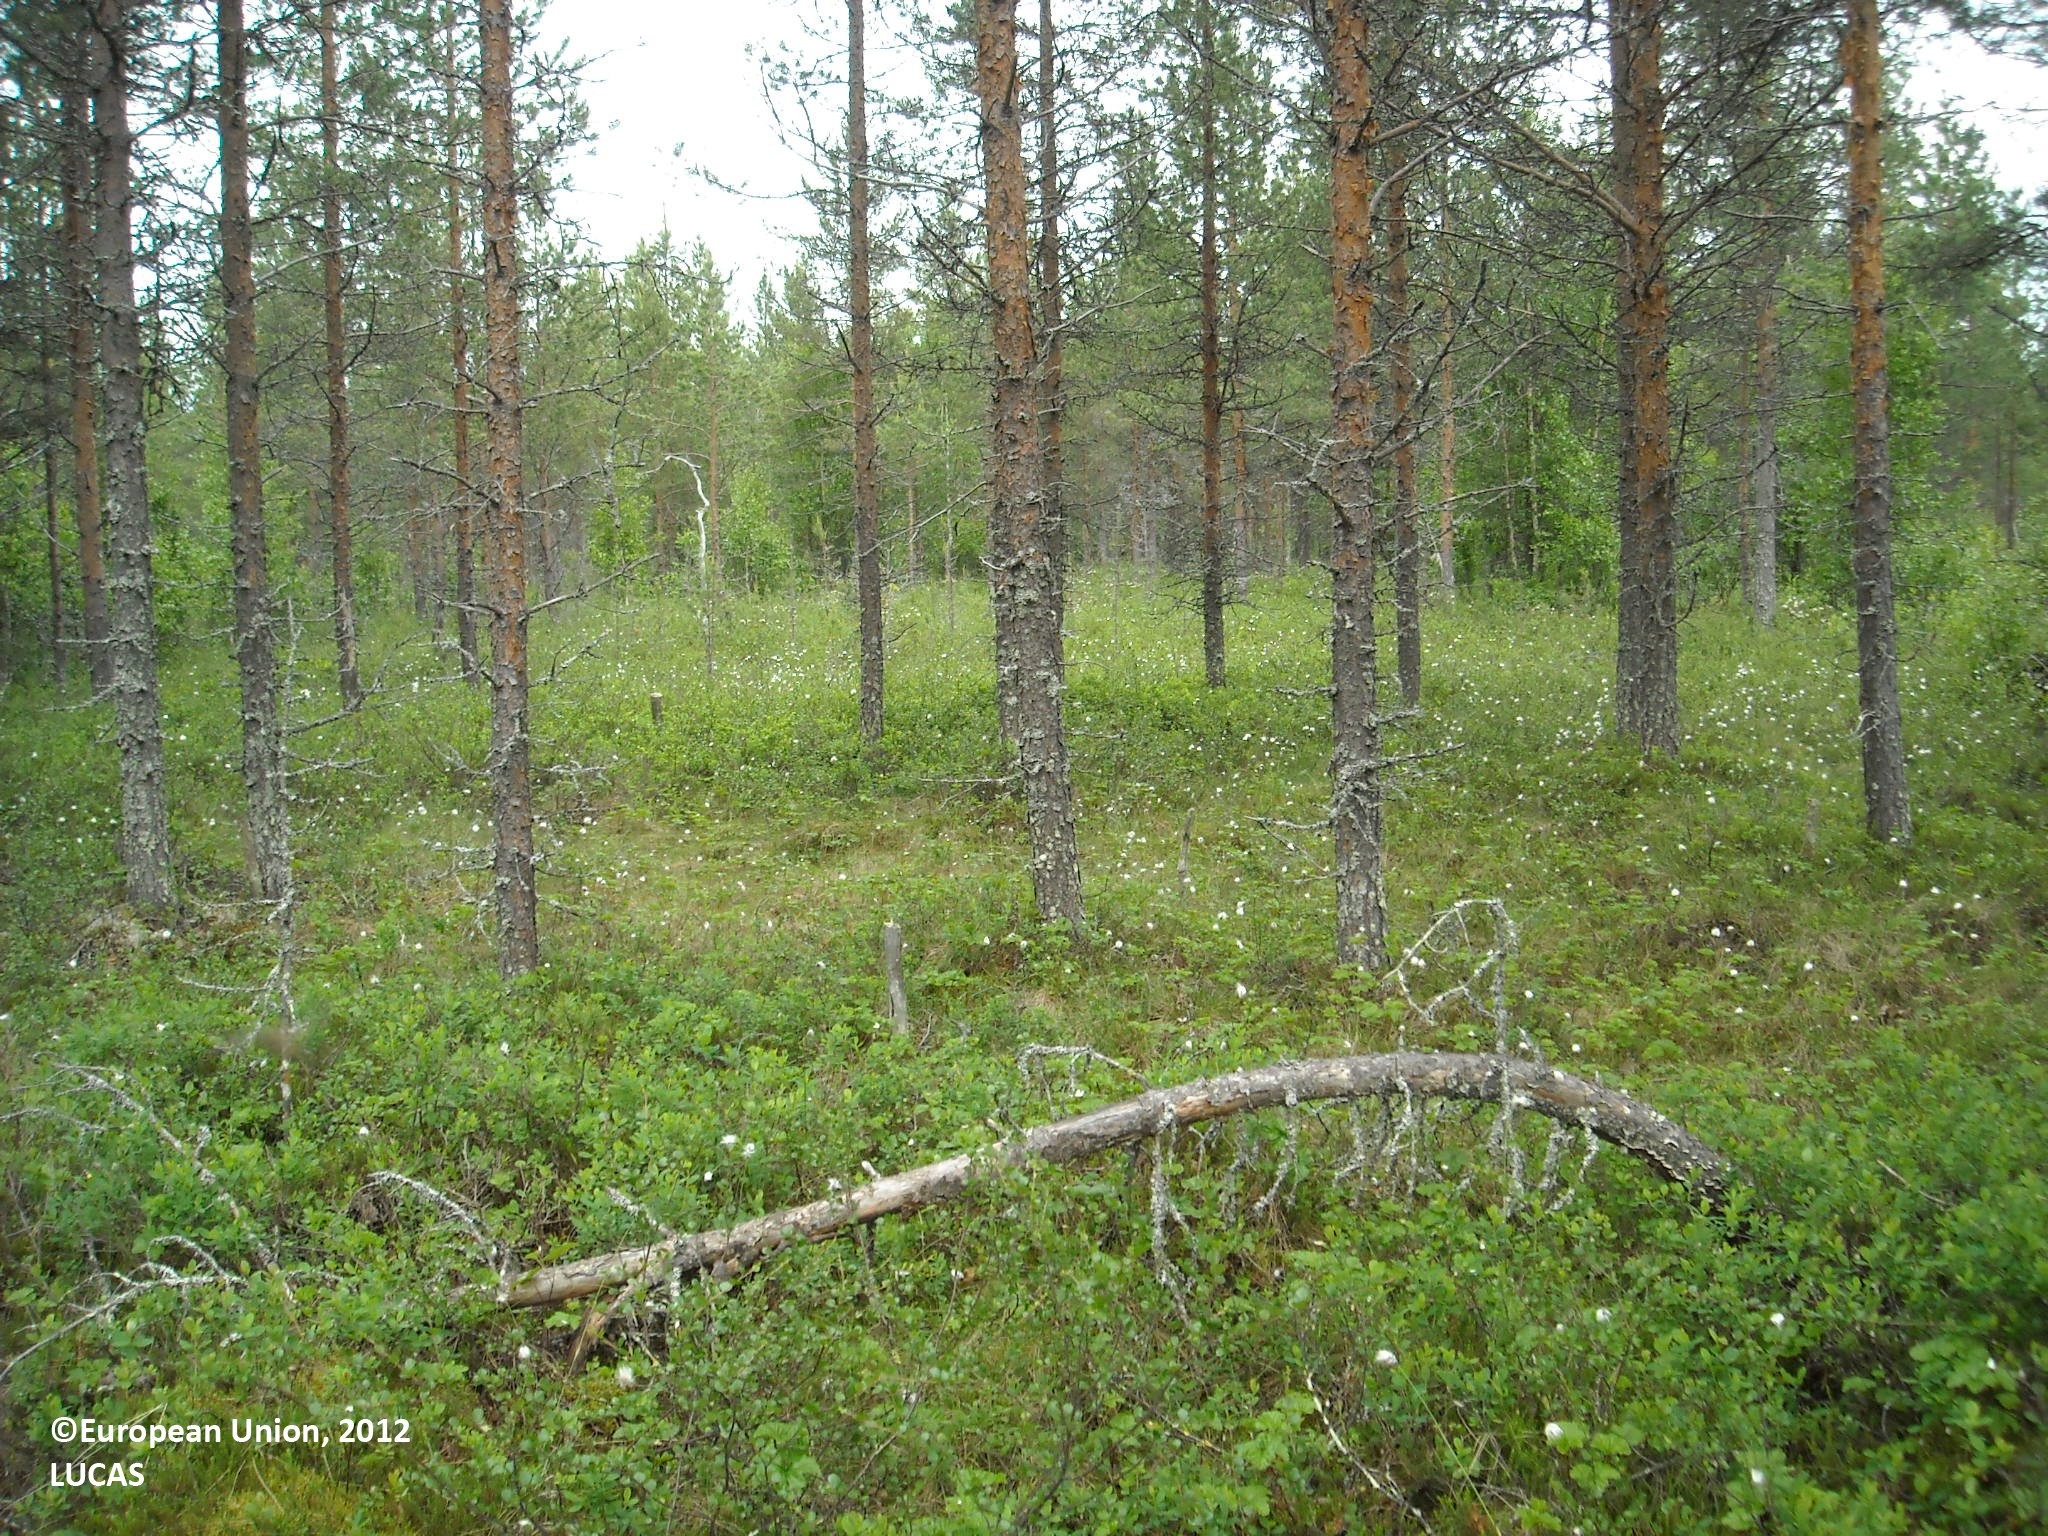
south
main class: Woodland
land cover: Pine dominated coniferous woodland
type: mire and swamp forests
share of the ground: 50 - 75 %
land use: Forestry
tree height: > 5 m
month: June
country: FI
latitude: 64.8435
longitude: 27.3594
